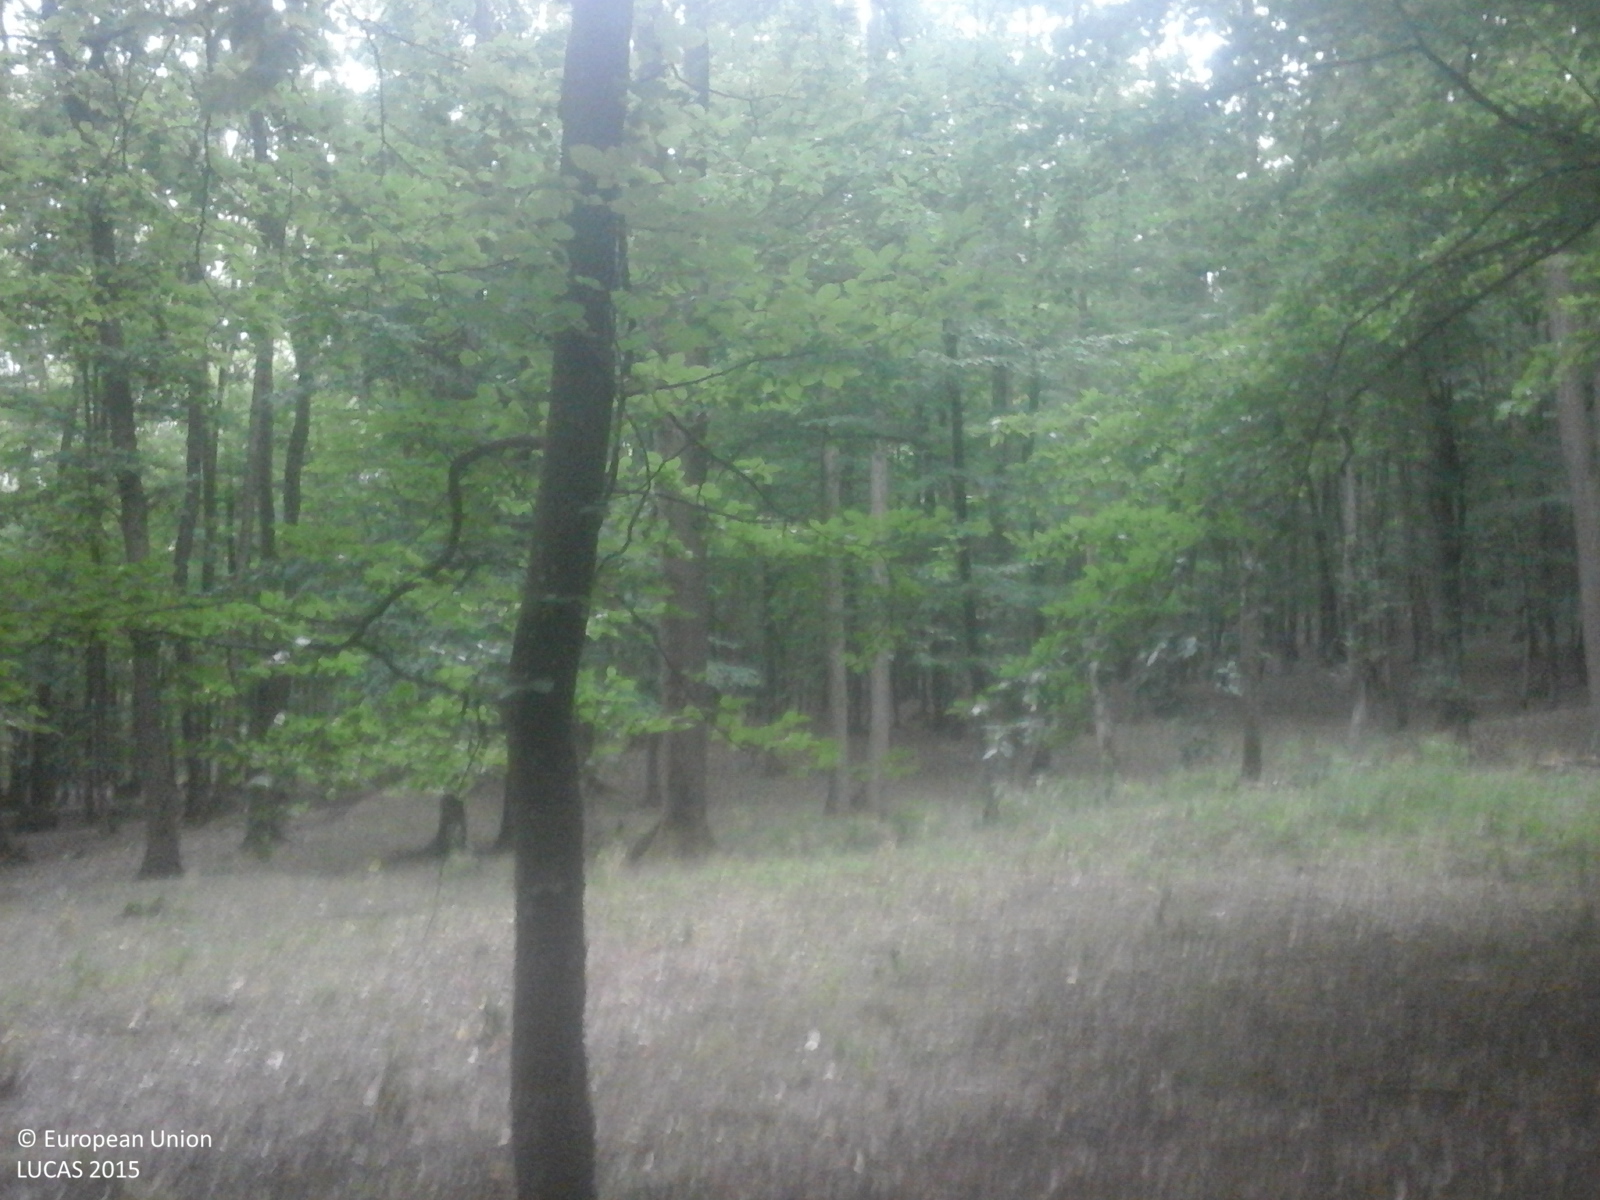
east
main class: Woodland
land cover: Broadleaved woodland
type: beech forest
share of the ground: > 75 %
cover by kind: broadleaved forest trees 95 %, herbaceous plants 5 %
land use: Forestry
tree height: > 5 m
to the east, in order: Broadleaved woodland; Tracks; Broadleaved woodland
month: June
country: RO
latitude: 47.6382
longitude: 26.8025
